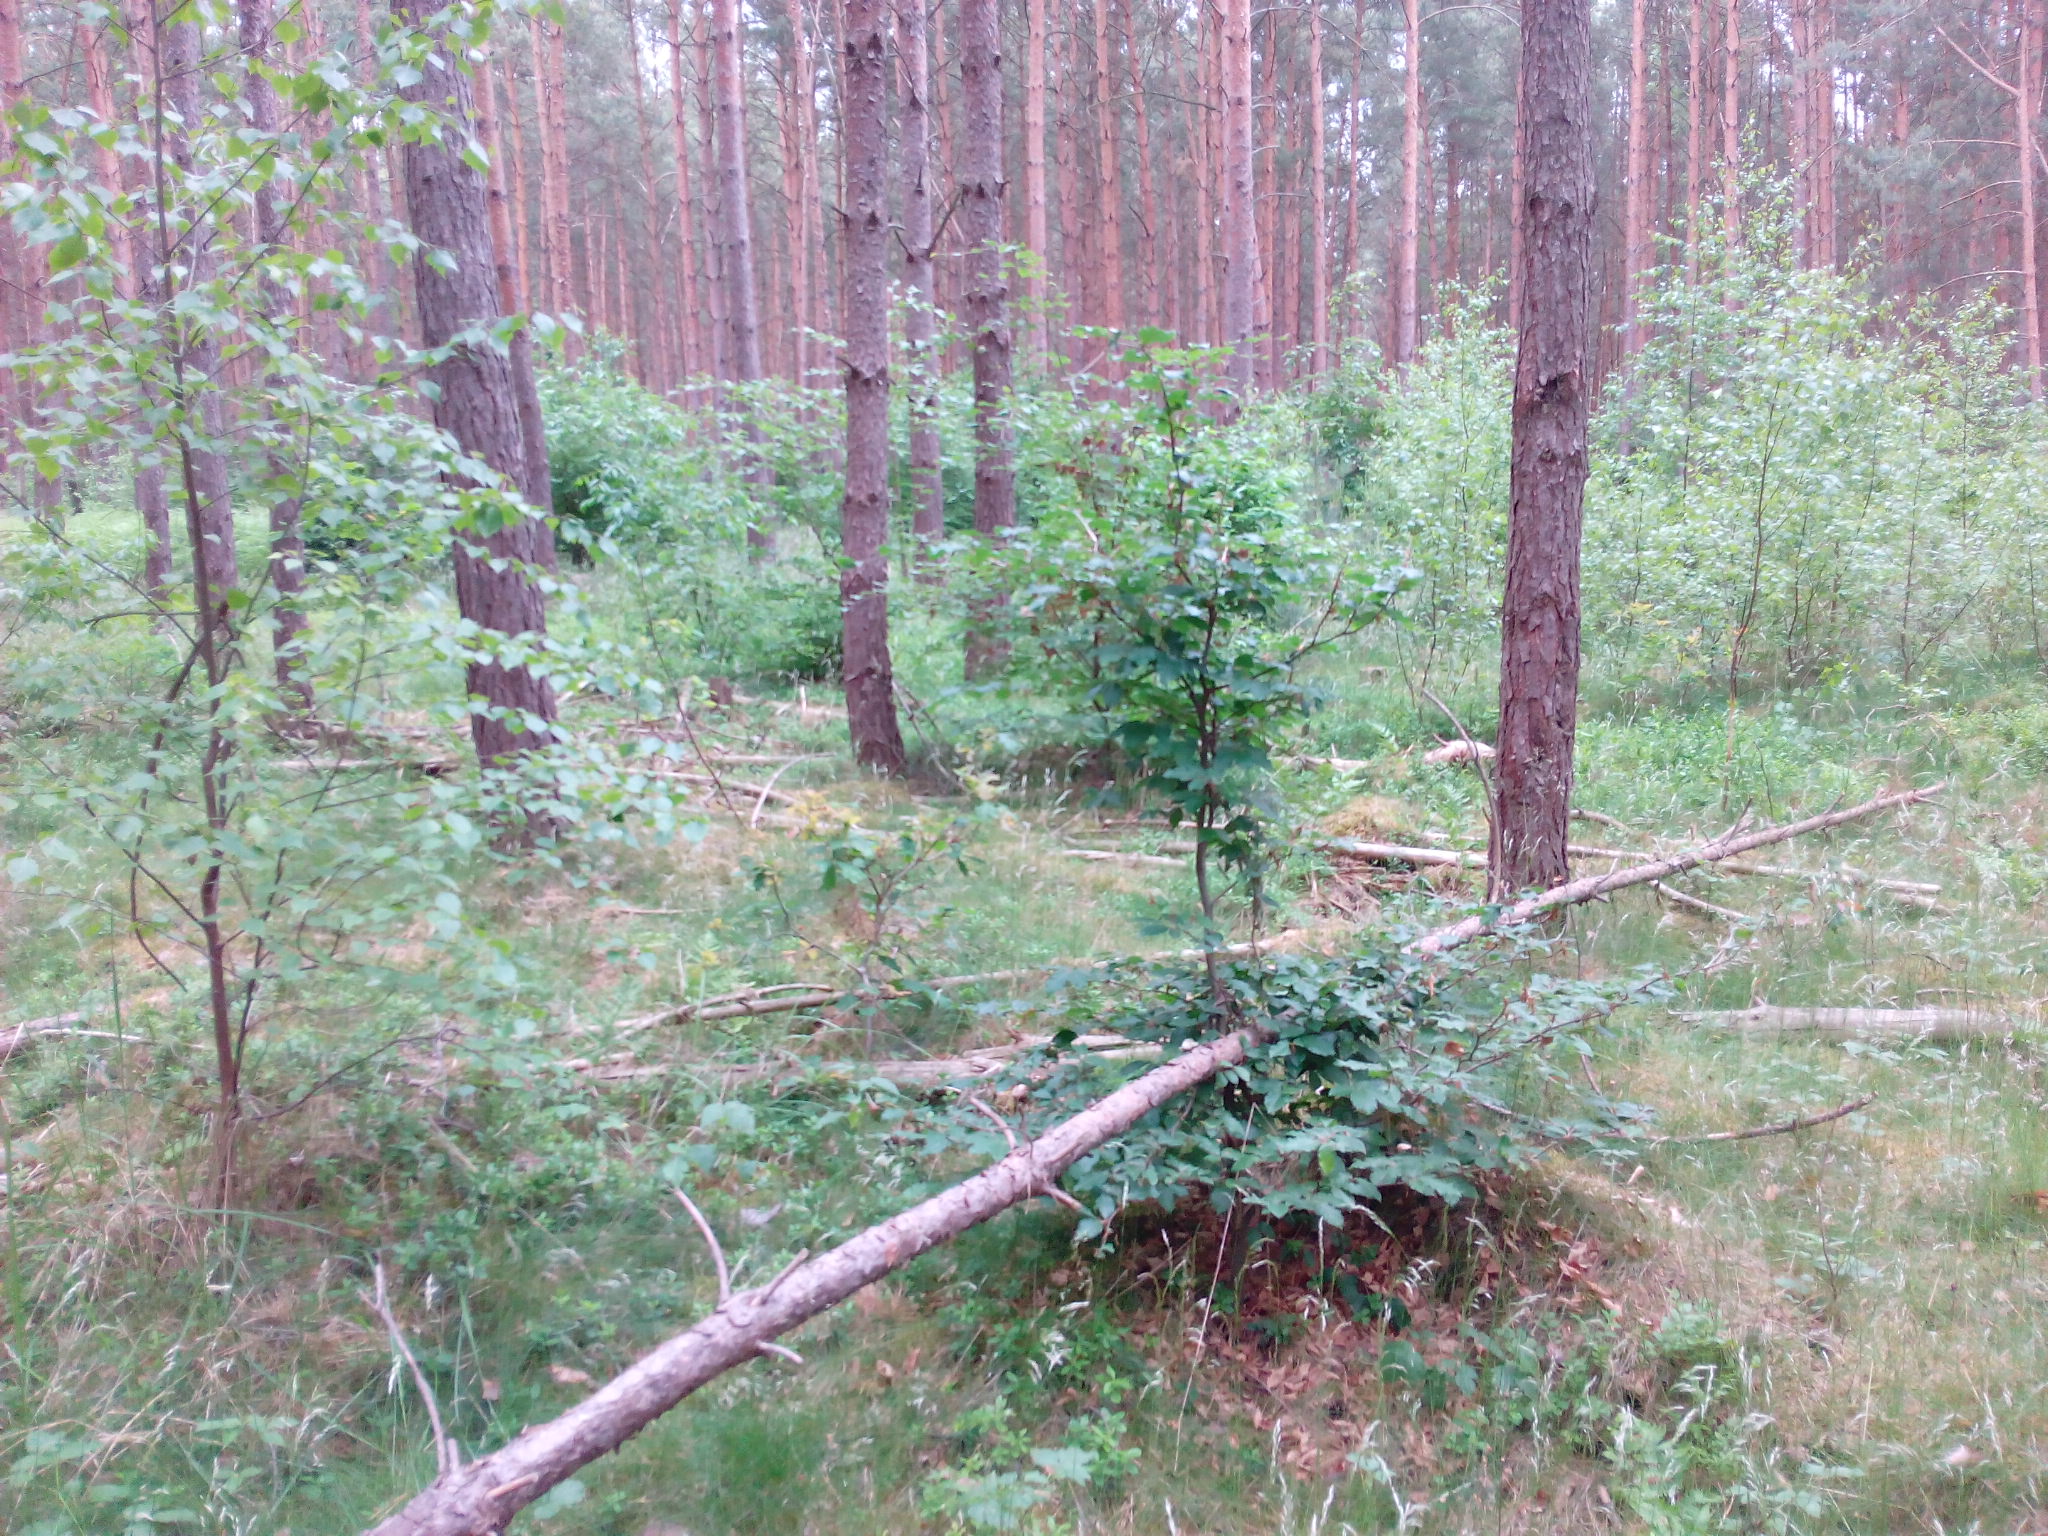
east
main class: Woodland
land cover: Pine dominated coniferous woodland
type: hemiboreal forest and nemoral coniferous forest and mixed broadleaved-coniferous forest
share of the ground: 50 - 75 %
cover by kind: coniferous forest trees 60 %, herbaceous plants 15 %, lichens and mosses 15 %, shrubs 10 %
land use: Forestry
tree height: > 5 m
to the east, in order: Pine dominated coniferous woodland
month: June
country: DE
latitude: 53.0078
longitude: 13.5620
